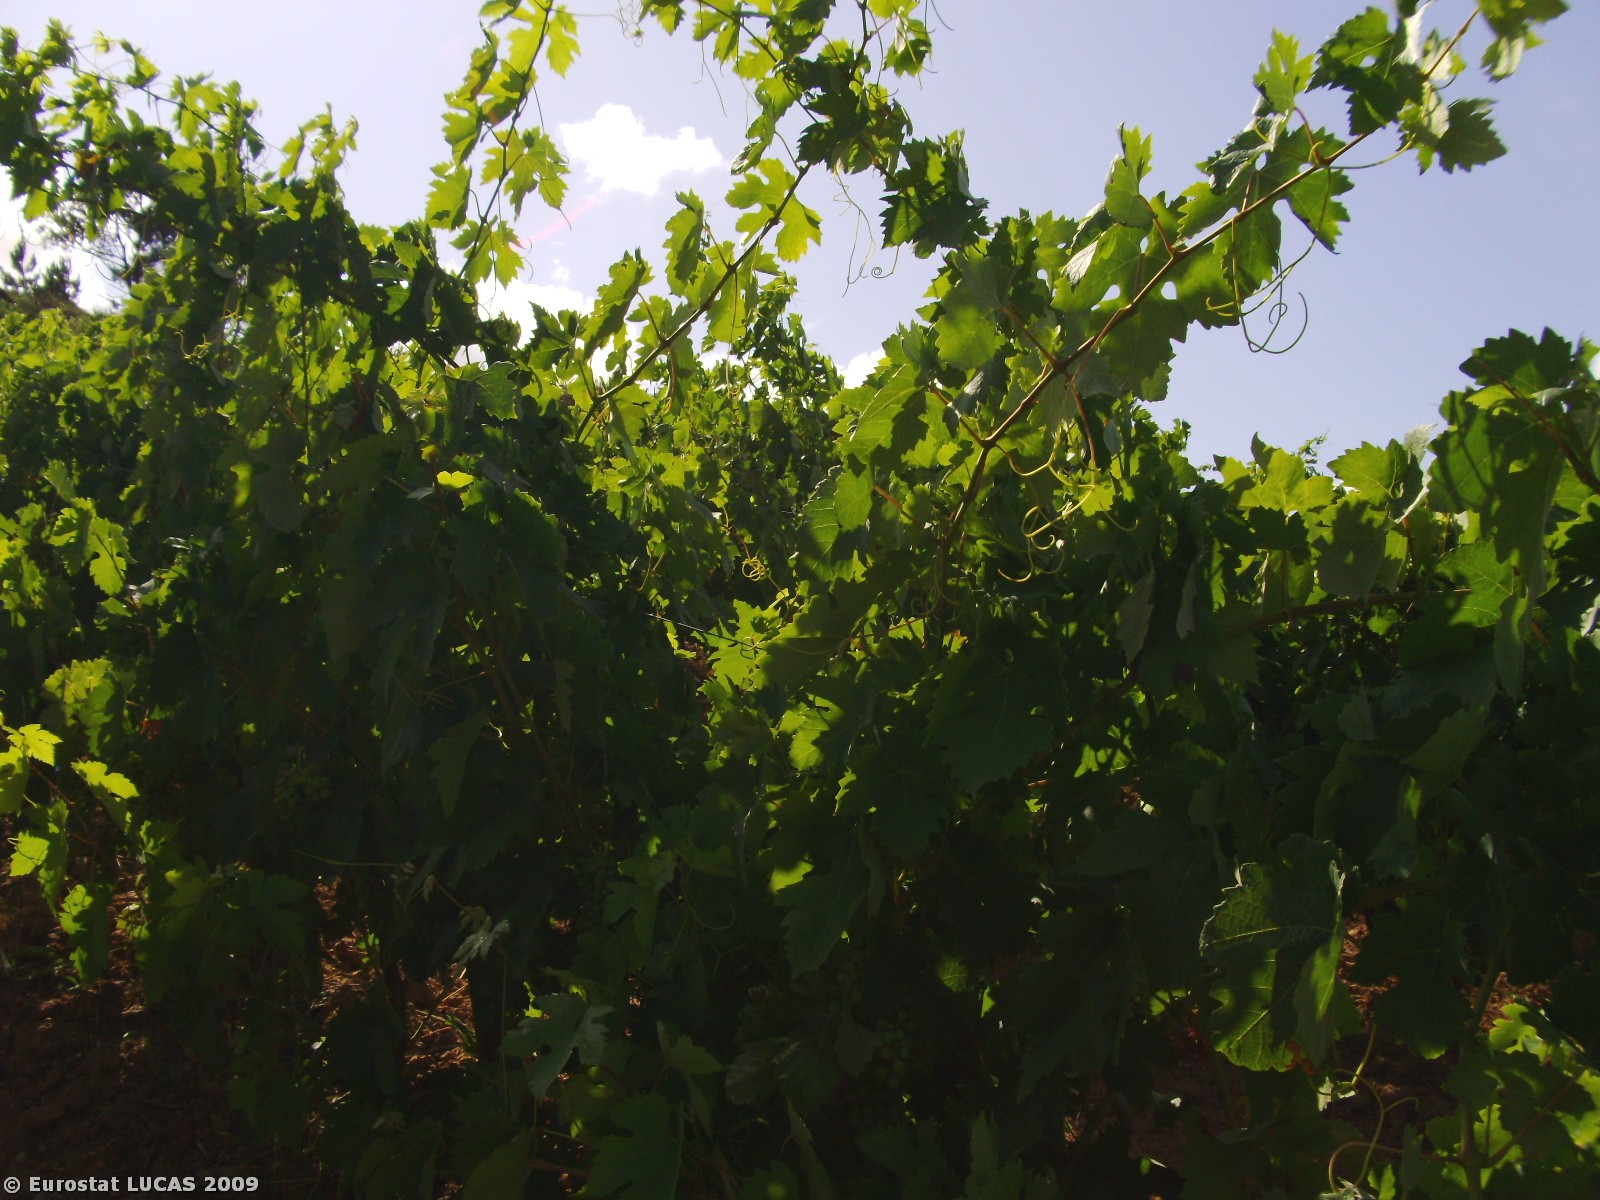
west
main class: Cropland
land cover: Vineyards
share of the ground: 50 - 75 %
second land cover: Bare land
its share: 25 - 50 %
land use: Agriculture (excluding fallow land and kitchen gardens)
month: July
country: PT
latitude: 39.0444
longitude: -9.2531
